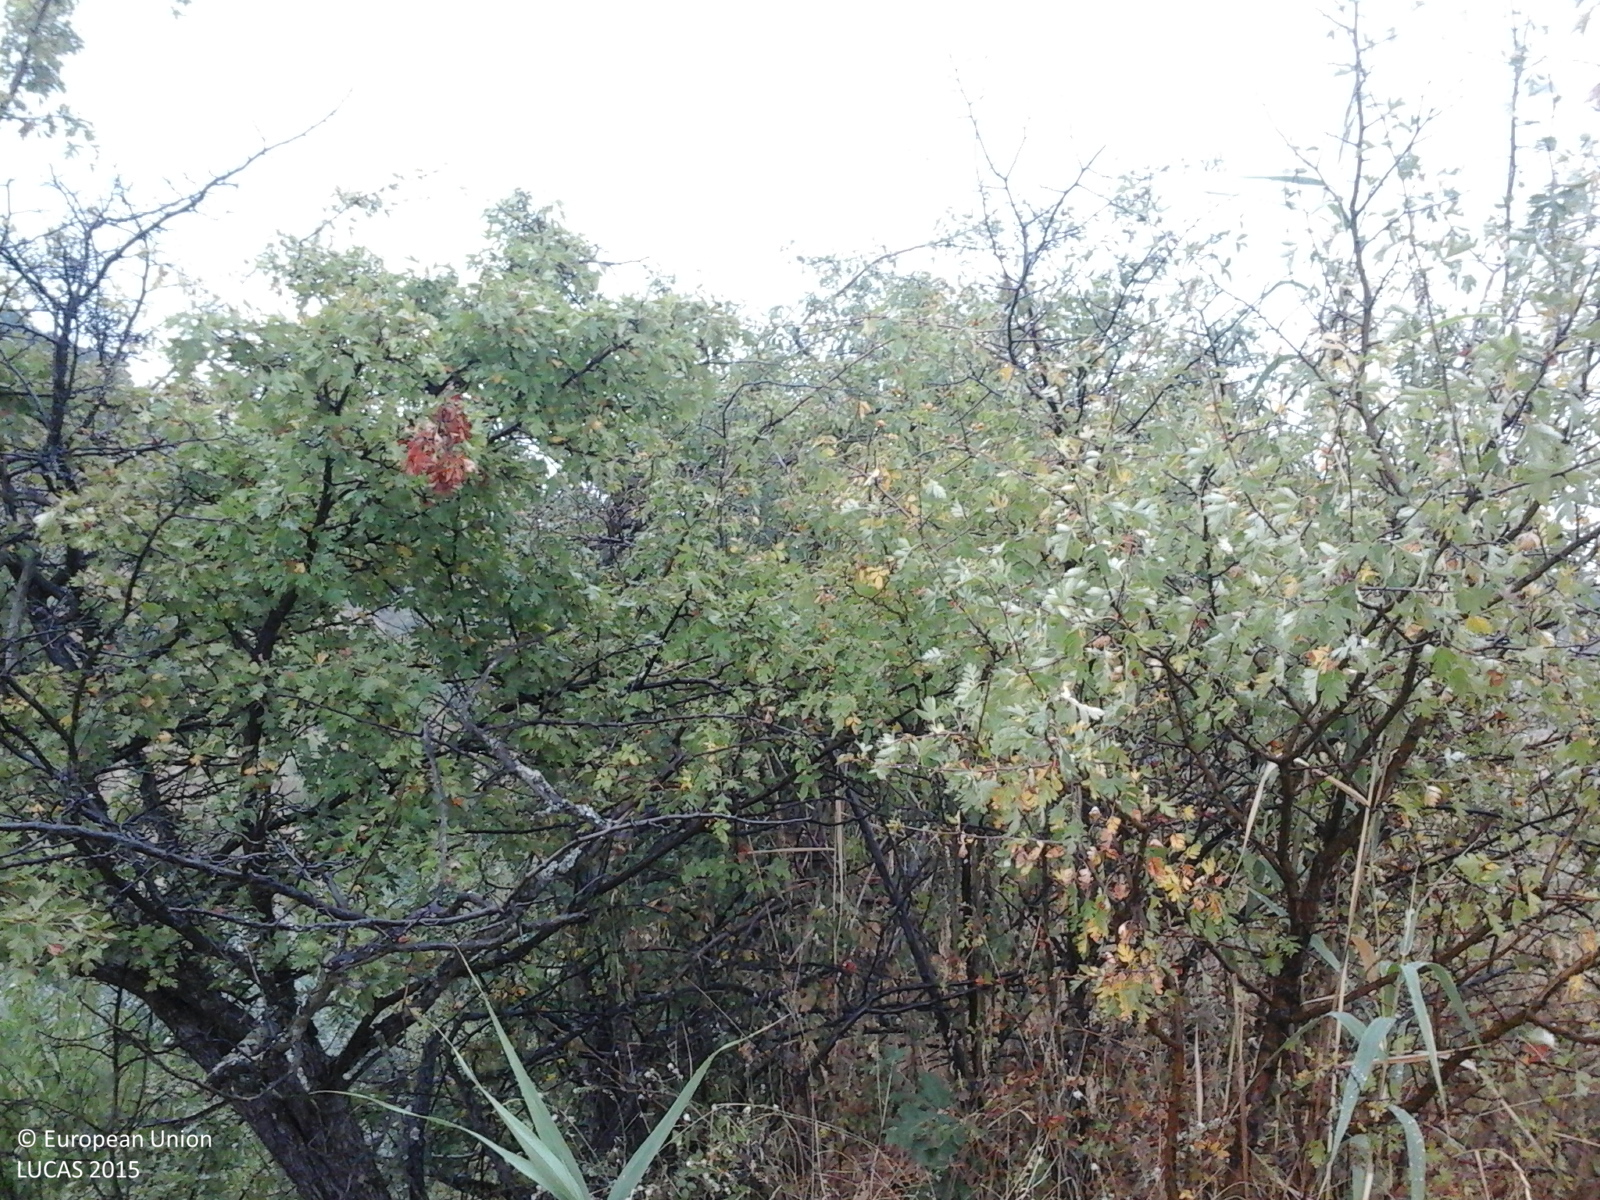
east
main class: Shrubland
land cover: Shrubland with sparse tree cover
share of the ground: > 75 %
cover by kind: shrubs 95 %, broadleaved forest trees 5 %
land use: Semi-natural and natural areas not in use
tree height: < 5 m
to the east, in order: Shrubland with sparse tree cover; Grassland with sparse tree/shrub cover; Broadleaved woodland
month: August
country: RO
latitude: 44.5610
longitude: 22.7712
